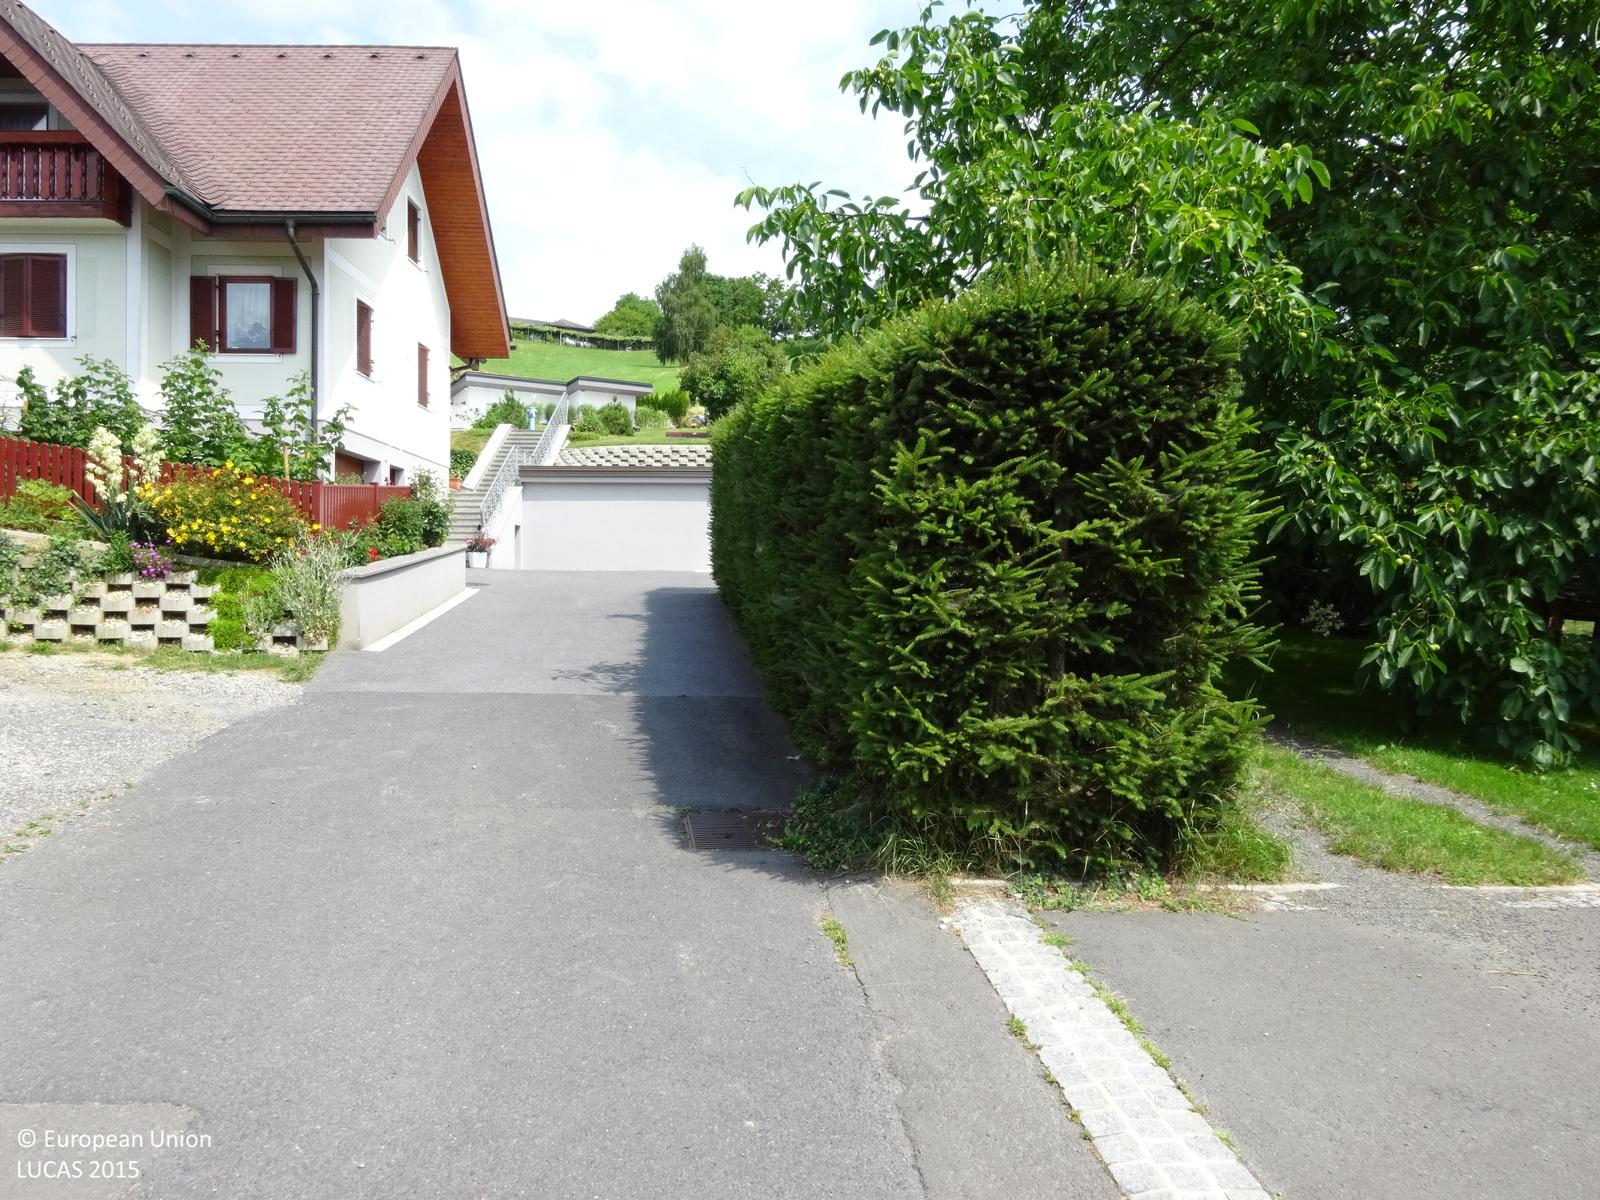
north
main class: Grassland
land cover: Grassland without tree/shrub cover
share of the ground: > 75 %
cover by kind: herbaceous plants 100 %
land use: Residential
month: July
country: AT
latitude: 46.9094
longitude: 15.9218
